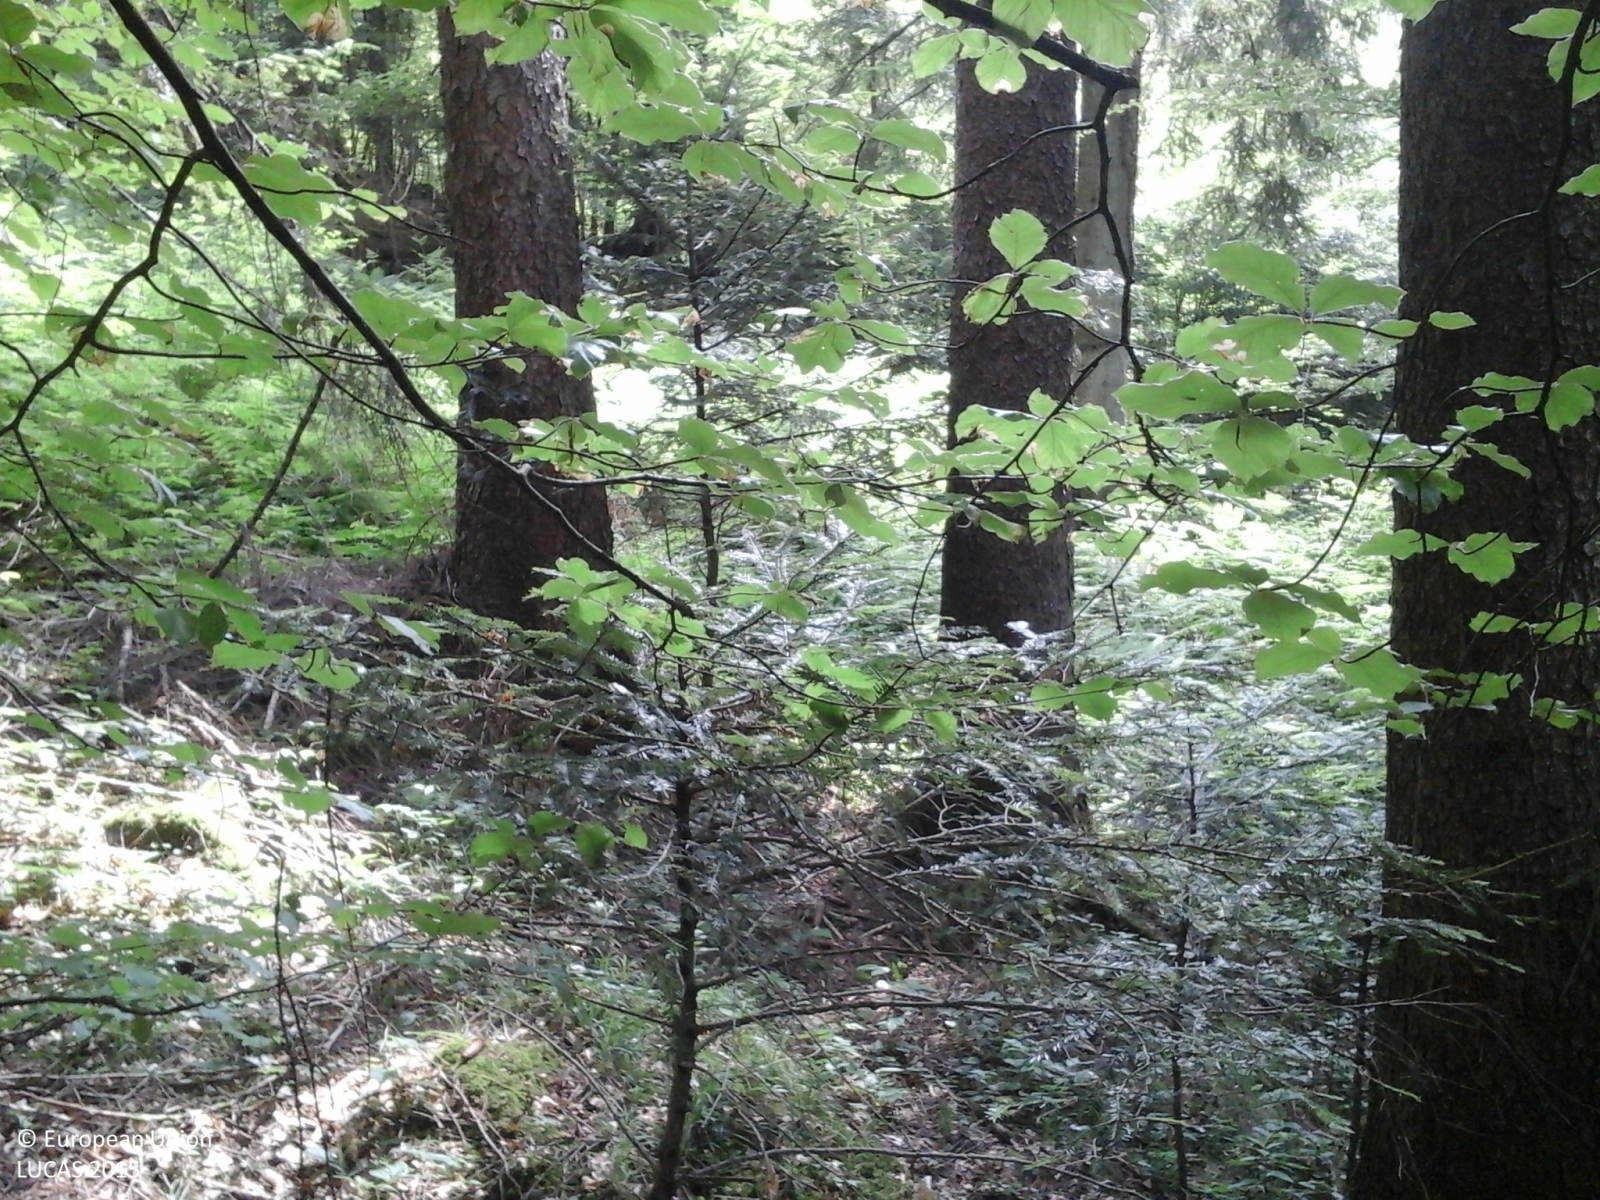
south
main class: Woodland
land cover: Other coniferous woodland
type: alpine coniferous forest
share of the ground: > 75 %
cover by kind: coniferous forest trees 95 %, broadleaved forest trees 5 %
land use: Forestry
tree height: > 5 m
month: June
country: IT
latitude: 45.9876
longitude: 10.8379
